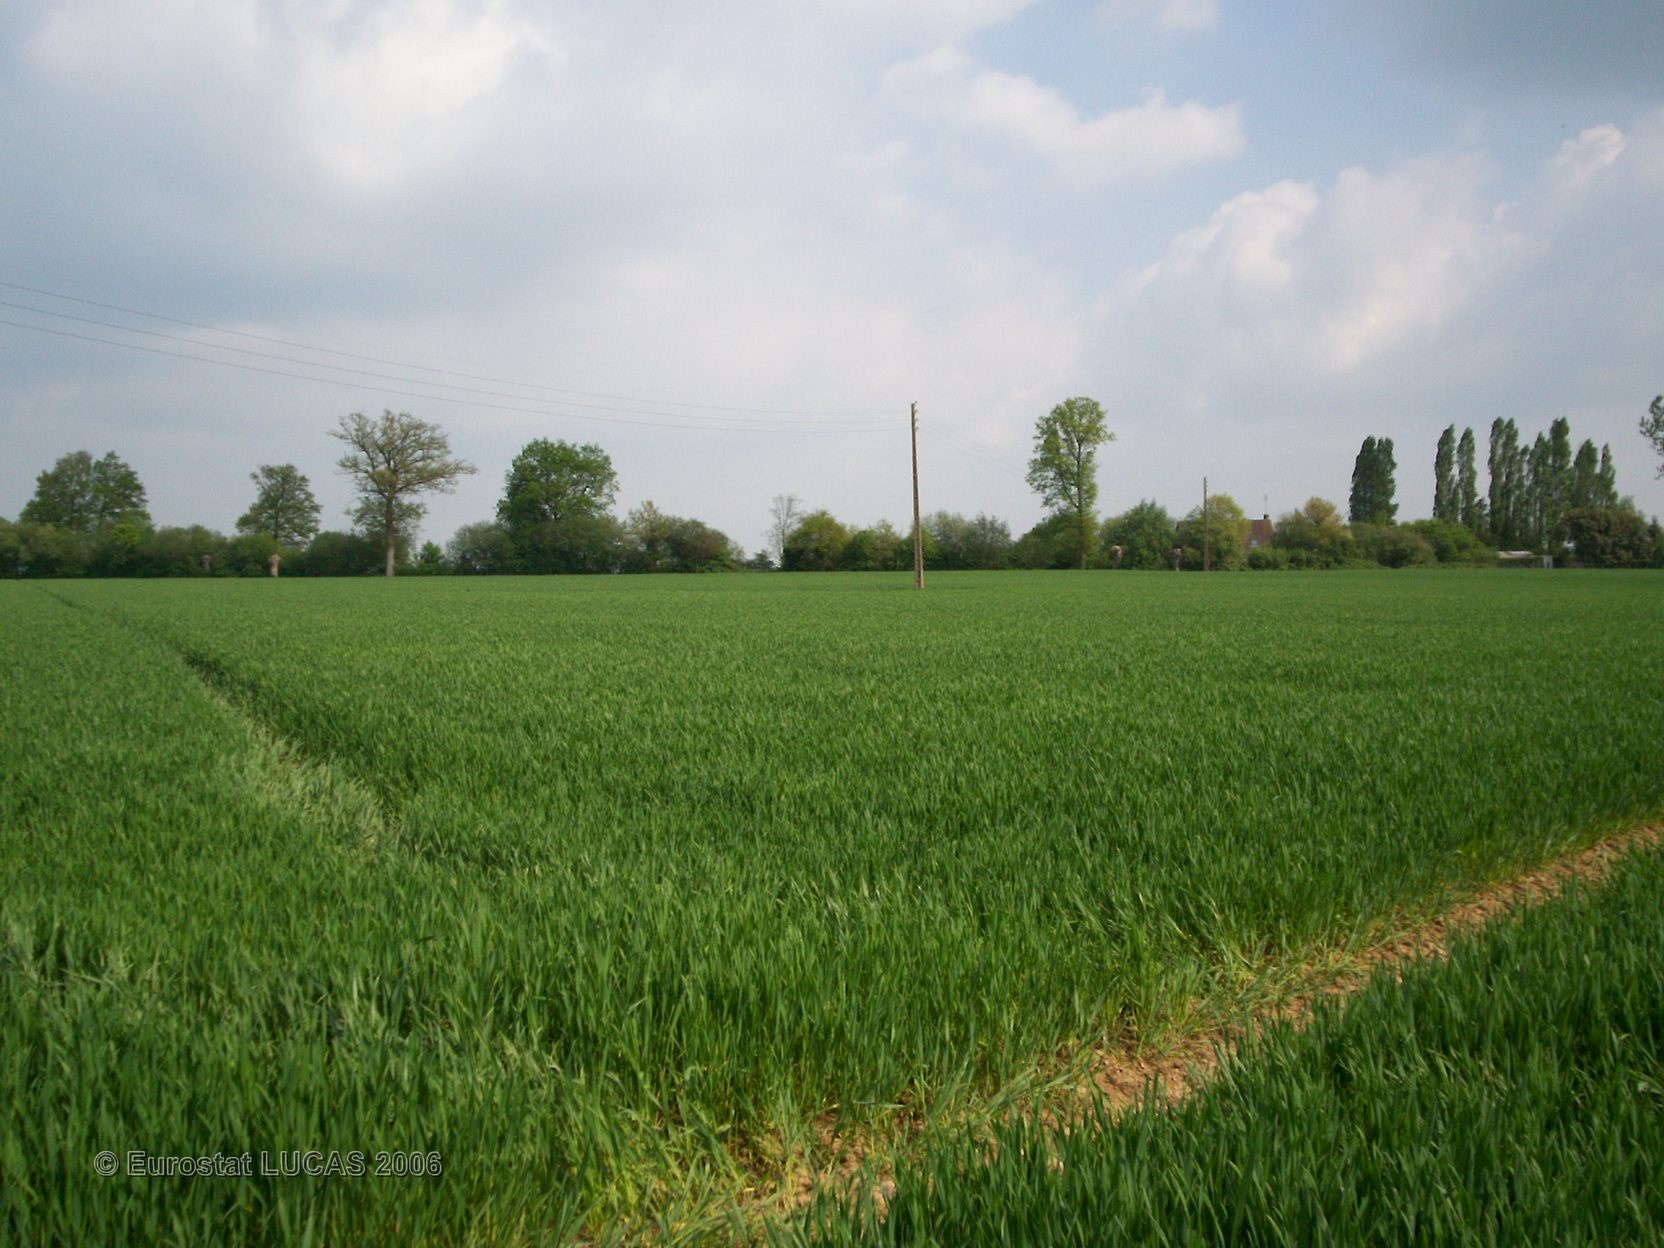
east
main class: Cropland
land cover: Common wheat
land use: Agriculture (excluding fallow land and kitchen gardens)
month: May
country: FR
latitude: 48.5191
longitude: 0.2930
